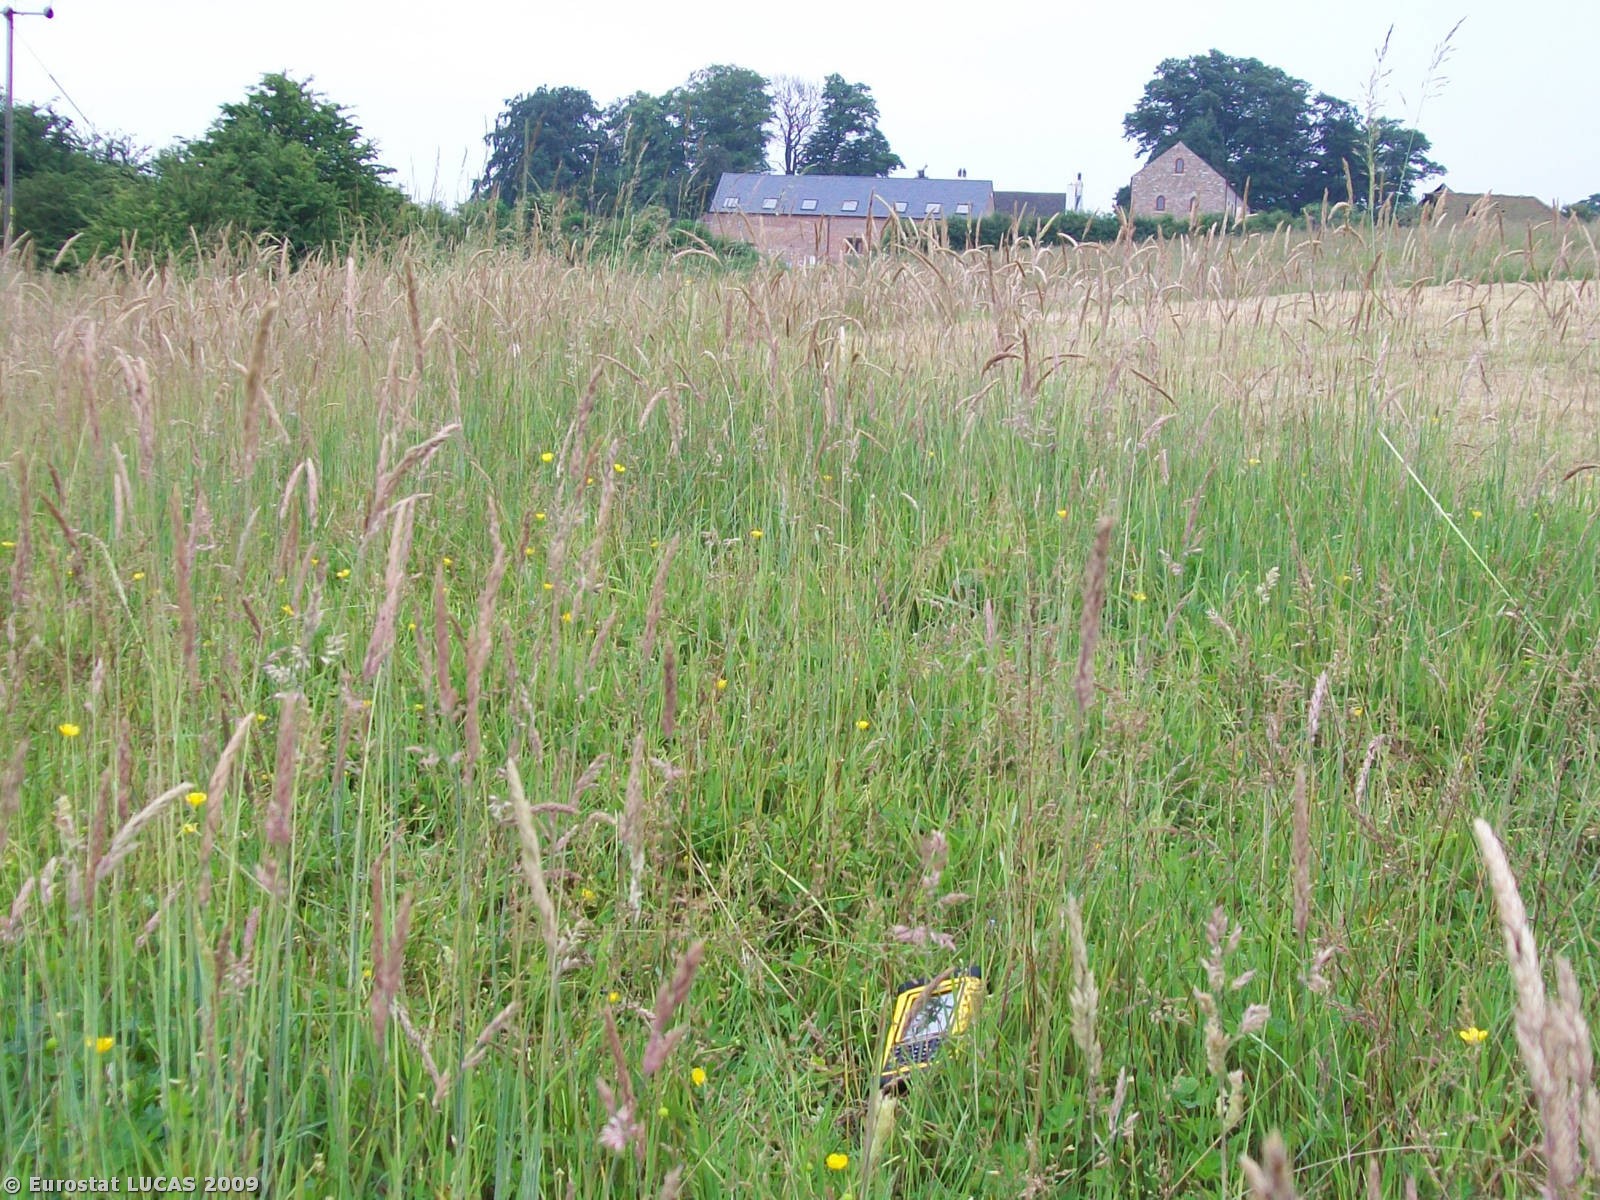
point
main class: Grassland
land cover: Grassland without tree/shrub cover
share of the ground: < 10 %
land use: Agriculture (excluding fallow land and kitchen gardens)
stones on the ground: < 10 %
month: July
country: GB
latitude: 53.8070
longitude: -1.3917
